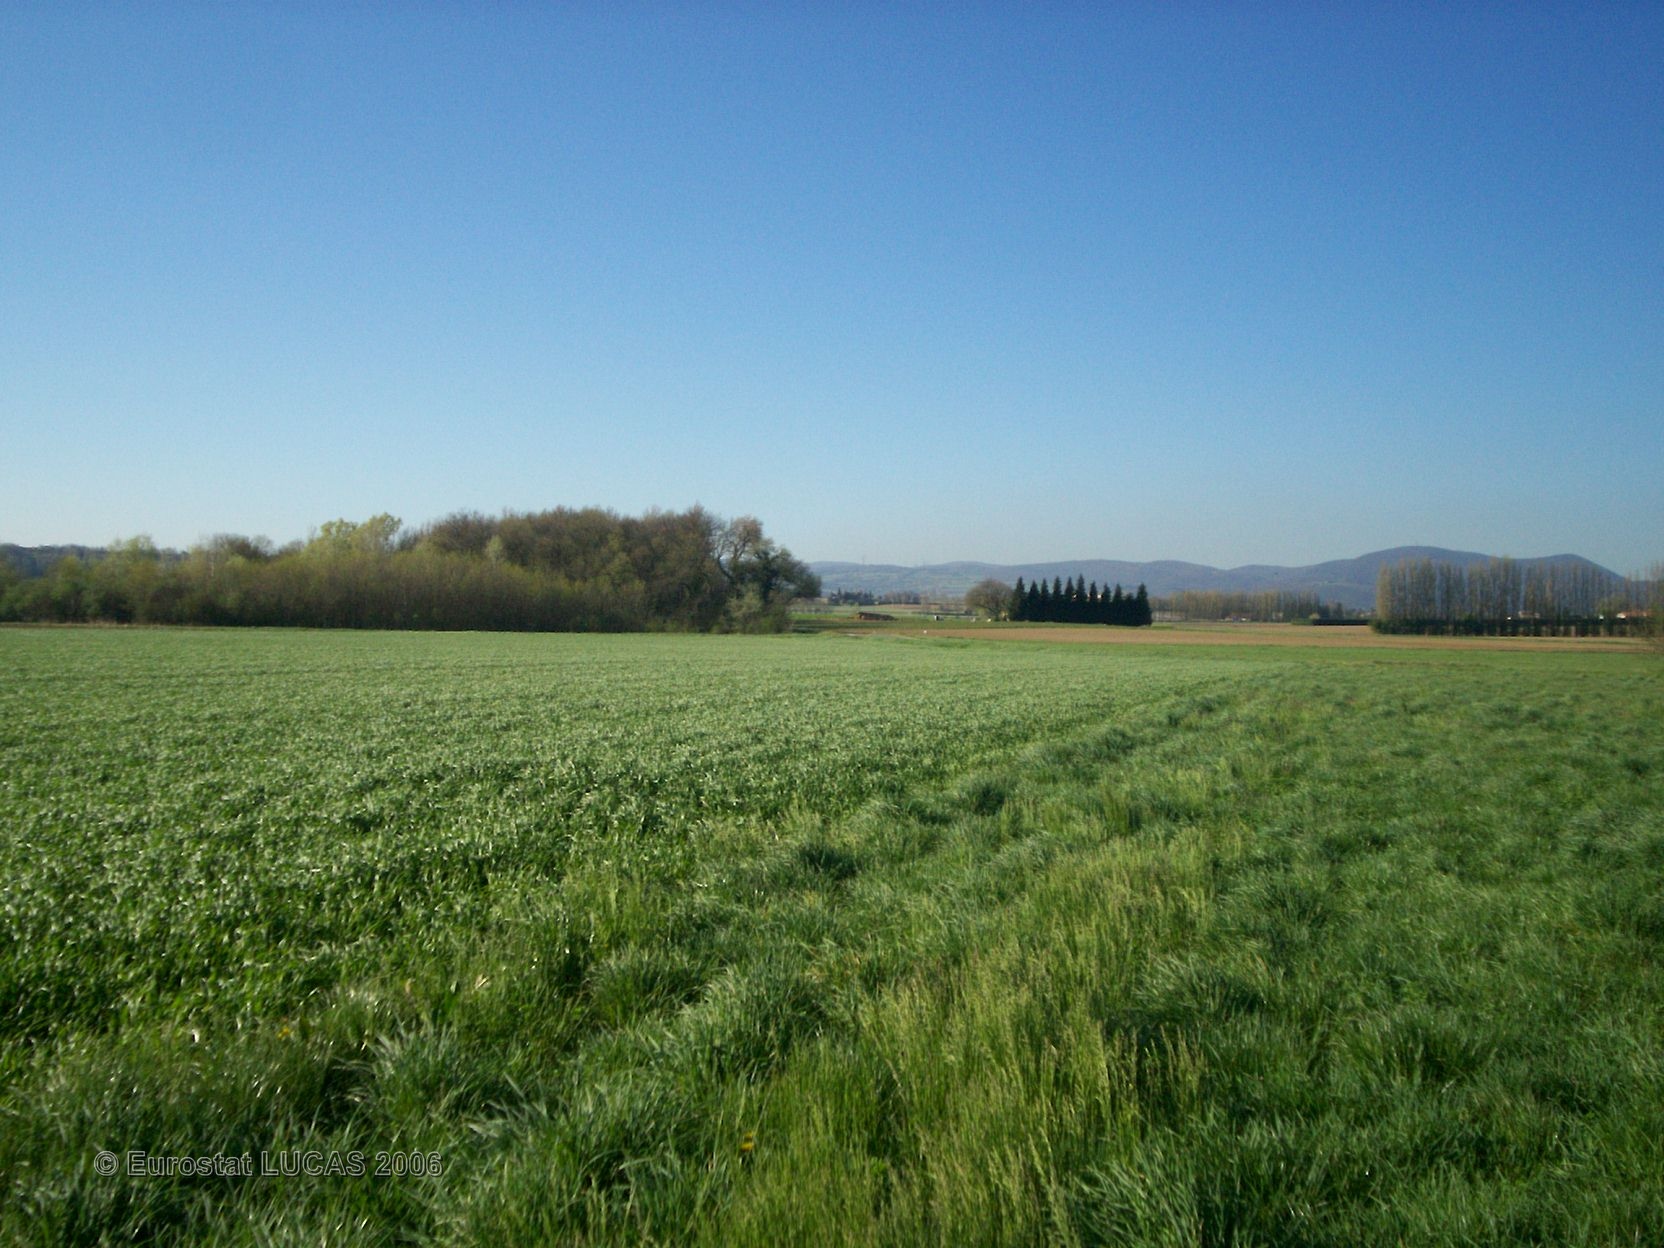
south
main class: Grassland
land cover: Grassland without tree/shrub cover
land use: Agriculture (excluding fallow land and kitchen gardens)
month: April
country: FR
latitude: 44.7858
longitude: 4.9127
